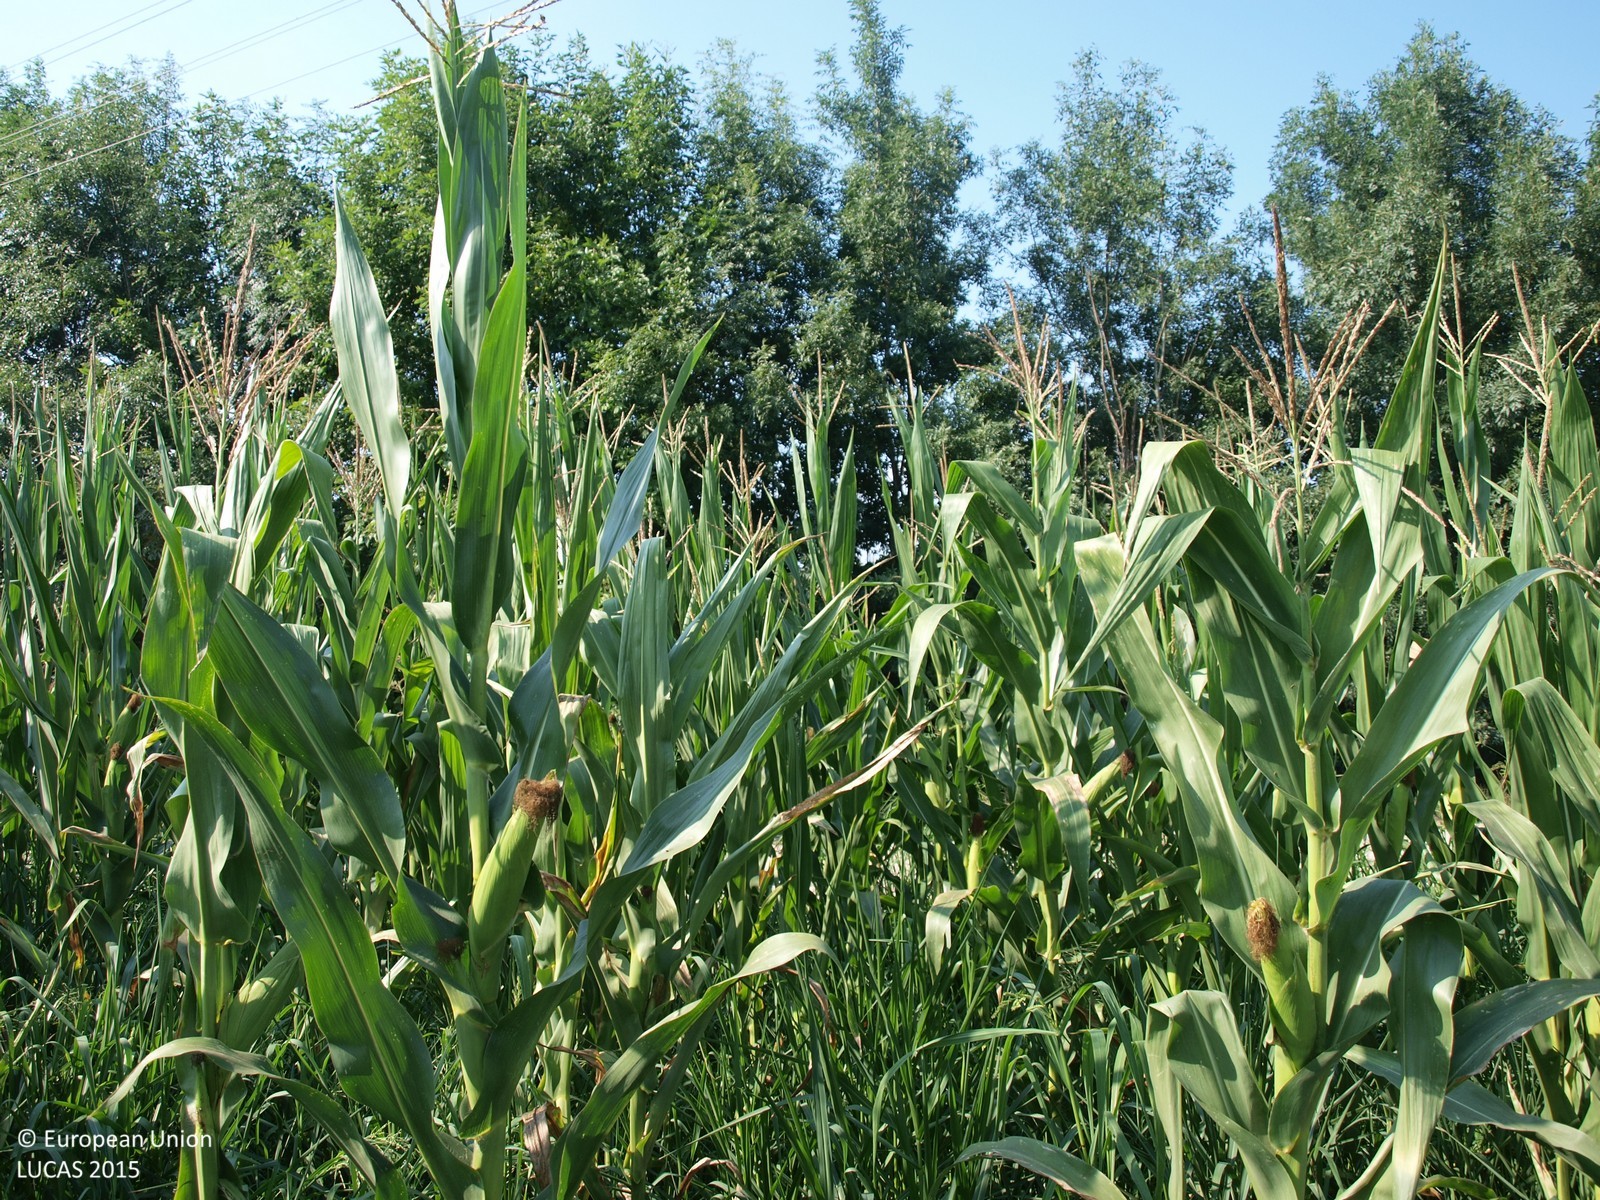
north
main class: Cropland
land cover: Maize
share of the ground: > 75 %
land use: Agriculture (excluding fallow land and kitchen gardens)
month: August
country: HR
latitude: 45.8641
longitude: 16.5042
